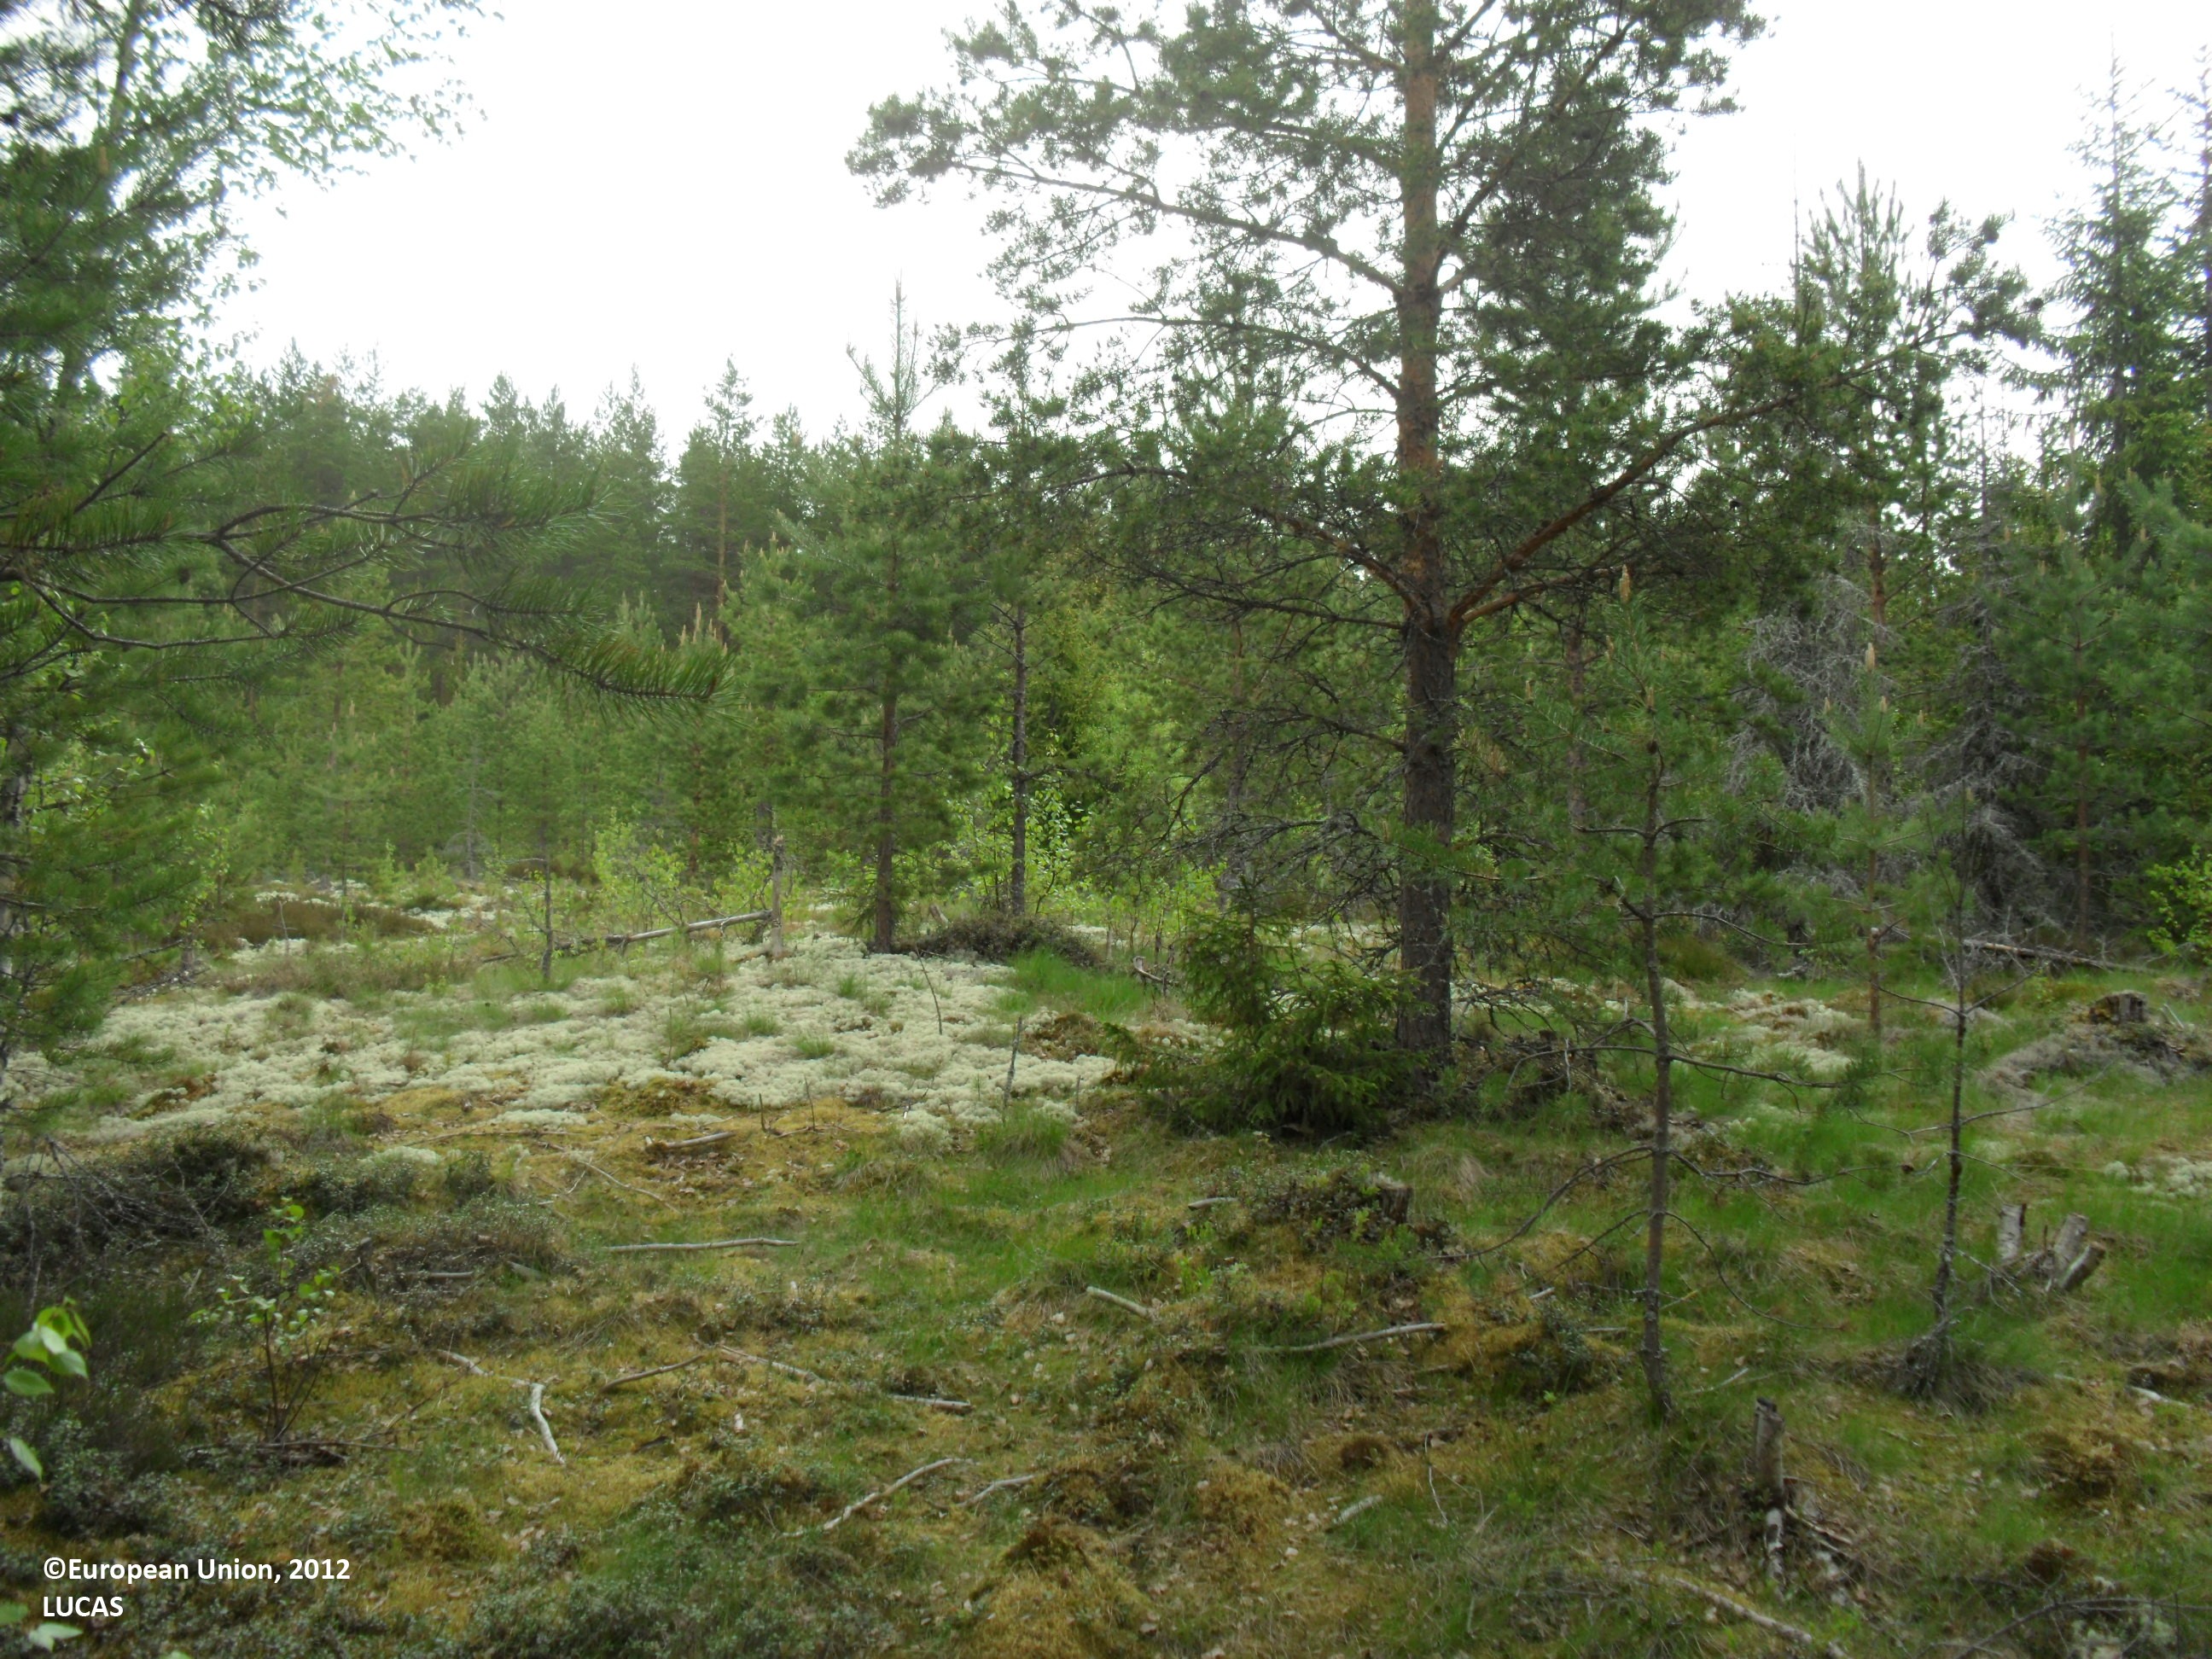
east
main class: Woodland
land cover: Pine dominated mixed woodland
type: boreal forest
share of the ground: 50 - 75 %
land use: Forestry
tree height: > 5 m
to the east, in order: Pine dominated mixed woodland; Ditches and canals; Pine dominated mixed woodland; Pine dominated coniferous woodland
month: June
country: FI
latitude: 63.0172
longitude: 22.9982
